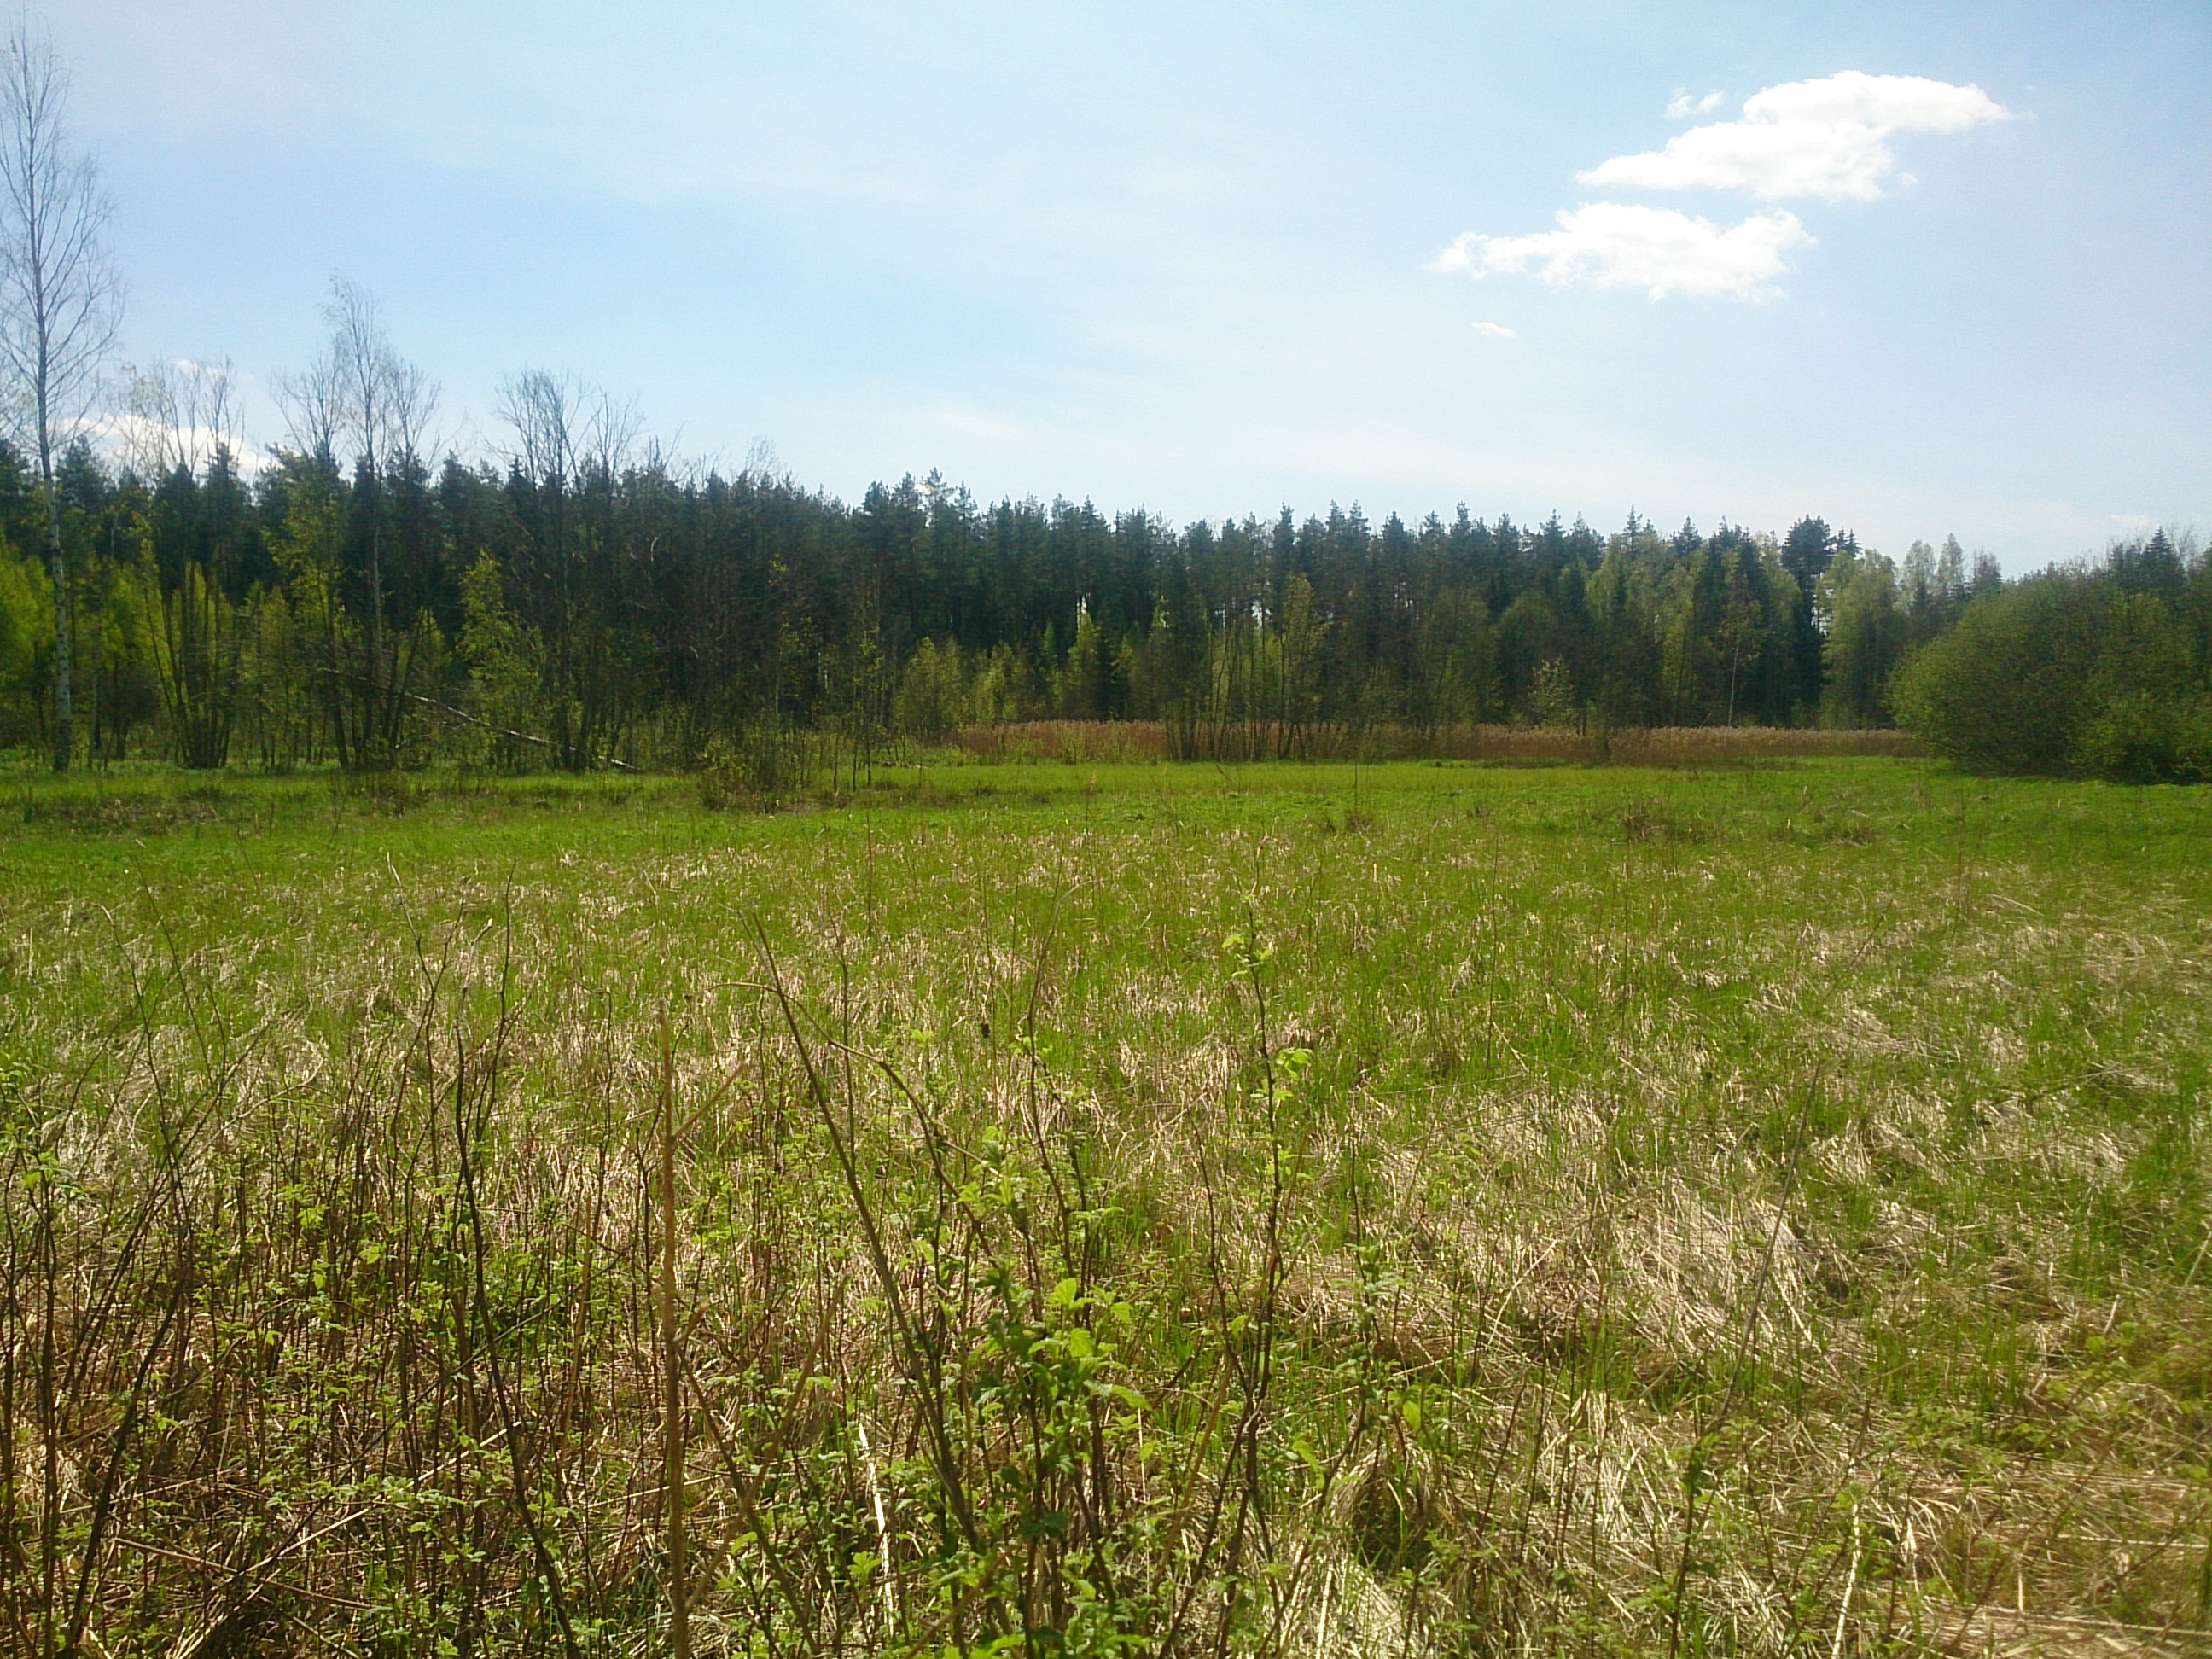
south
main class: Shrubland
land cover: Shrubland without tree cover
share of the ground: > 75 %
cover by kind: shrubs 70 %, herbaceous plants 30 %
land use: Semi-natural and natural areas not in use
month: May
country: LV
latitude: 56.6722
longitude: 24.3718
